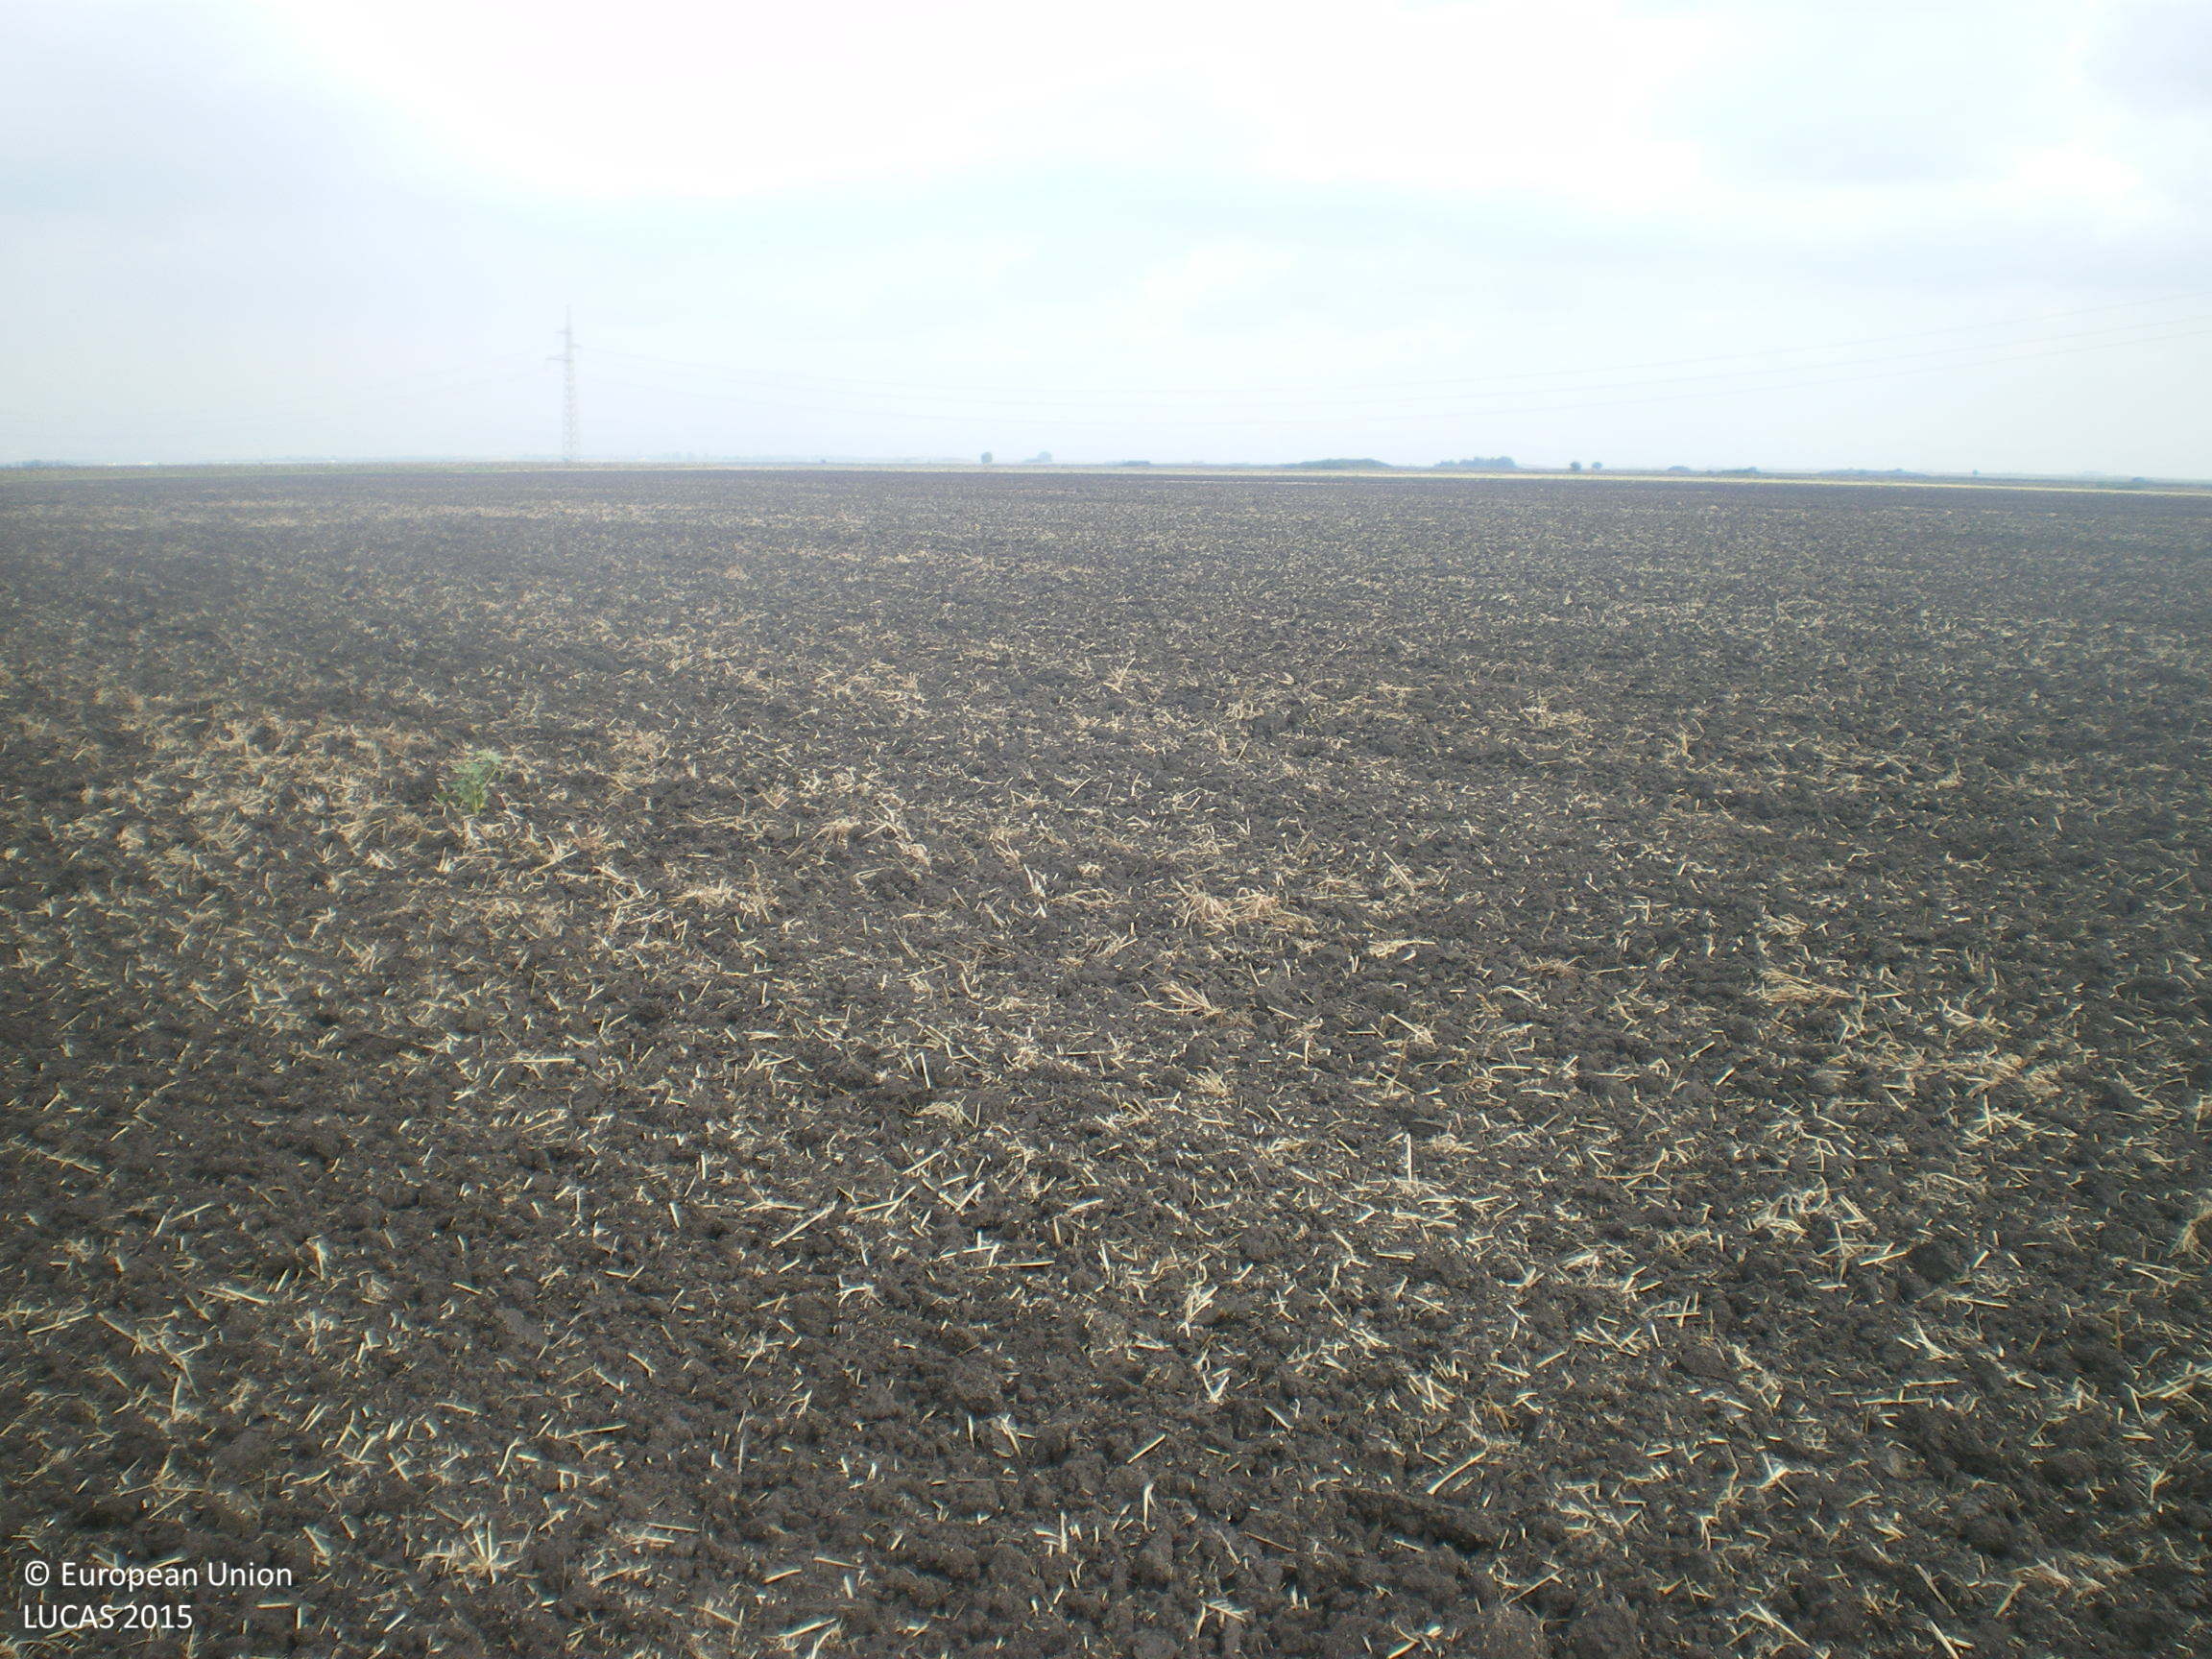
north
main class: Cropland
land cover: Common wheat
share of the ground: < 10 %
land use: Agriculture (excluding fallow land and kitchen gardens)
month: August
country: BG
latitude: 42.3626
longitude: 25.8979
